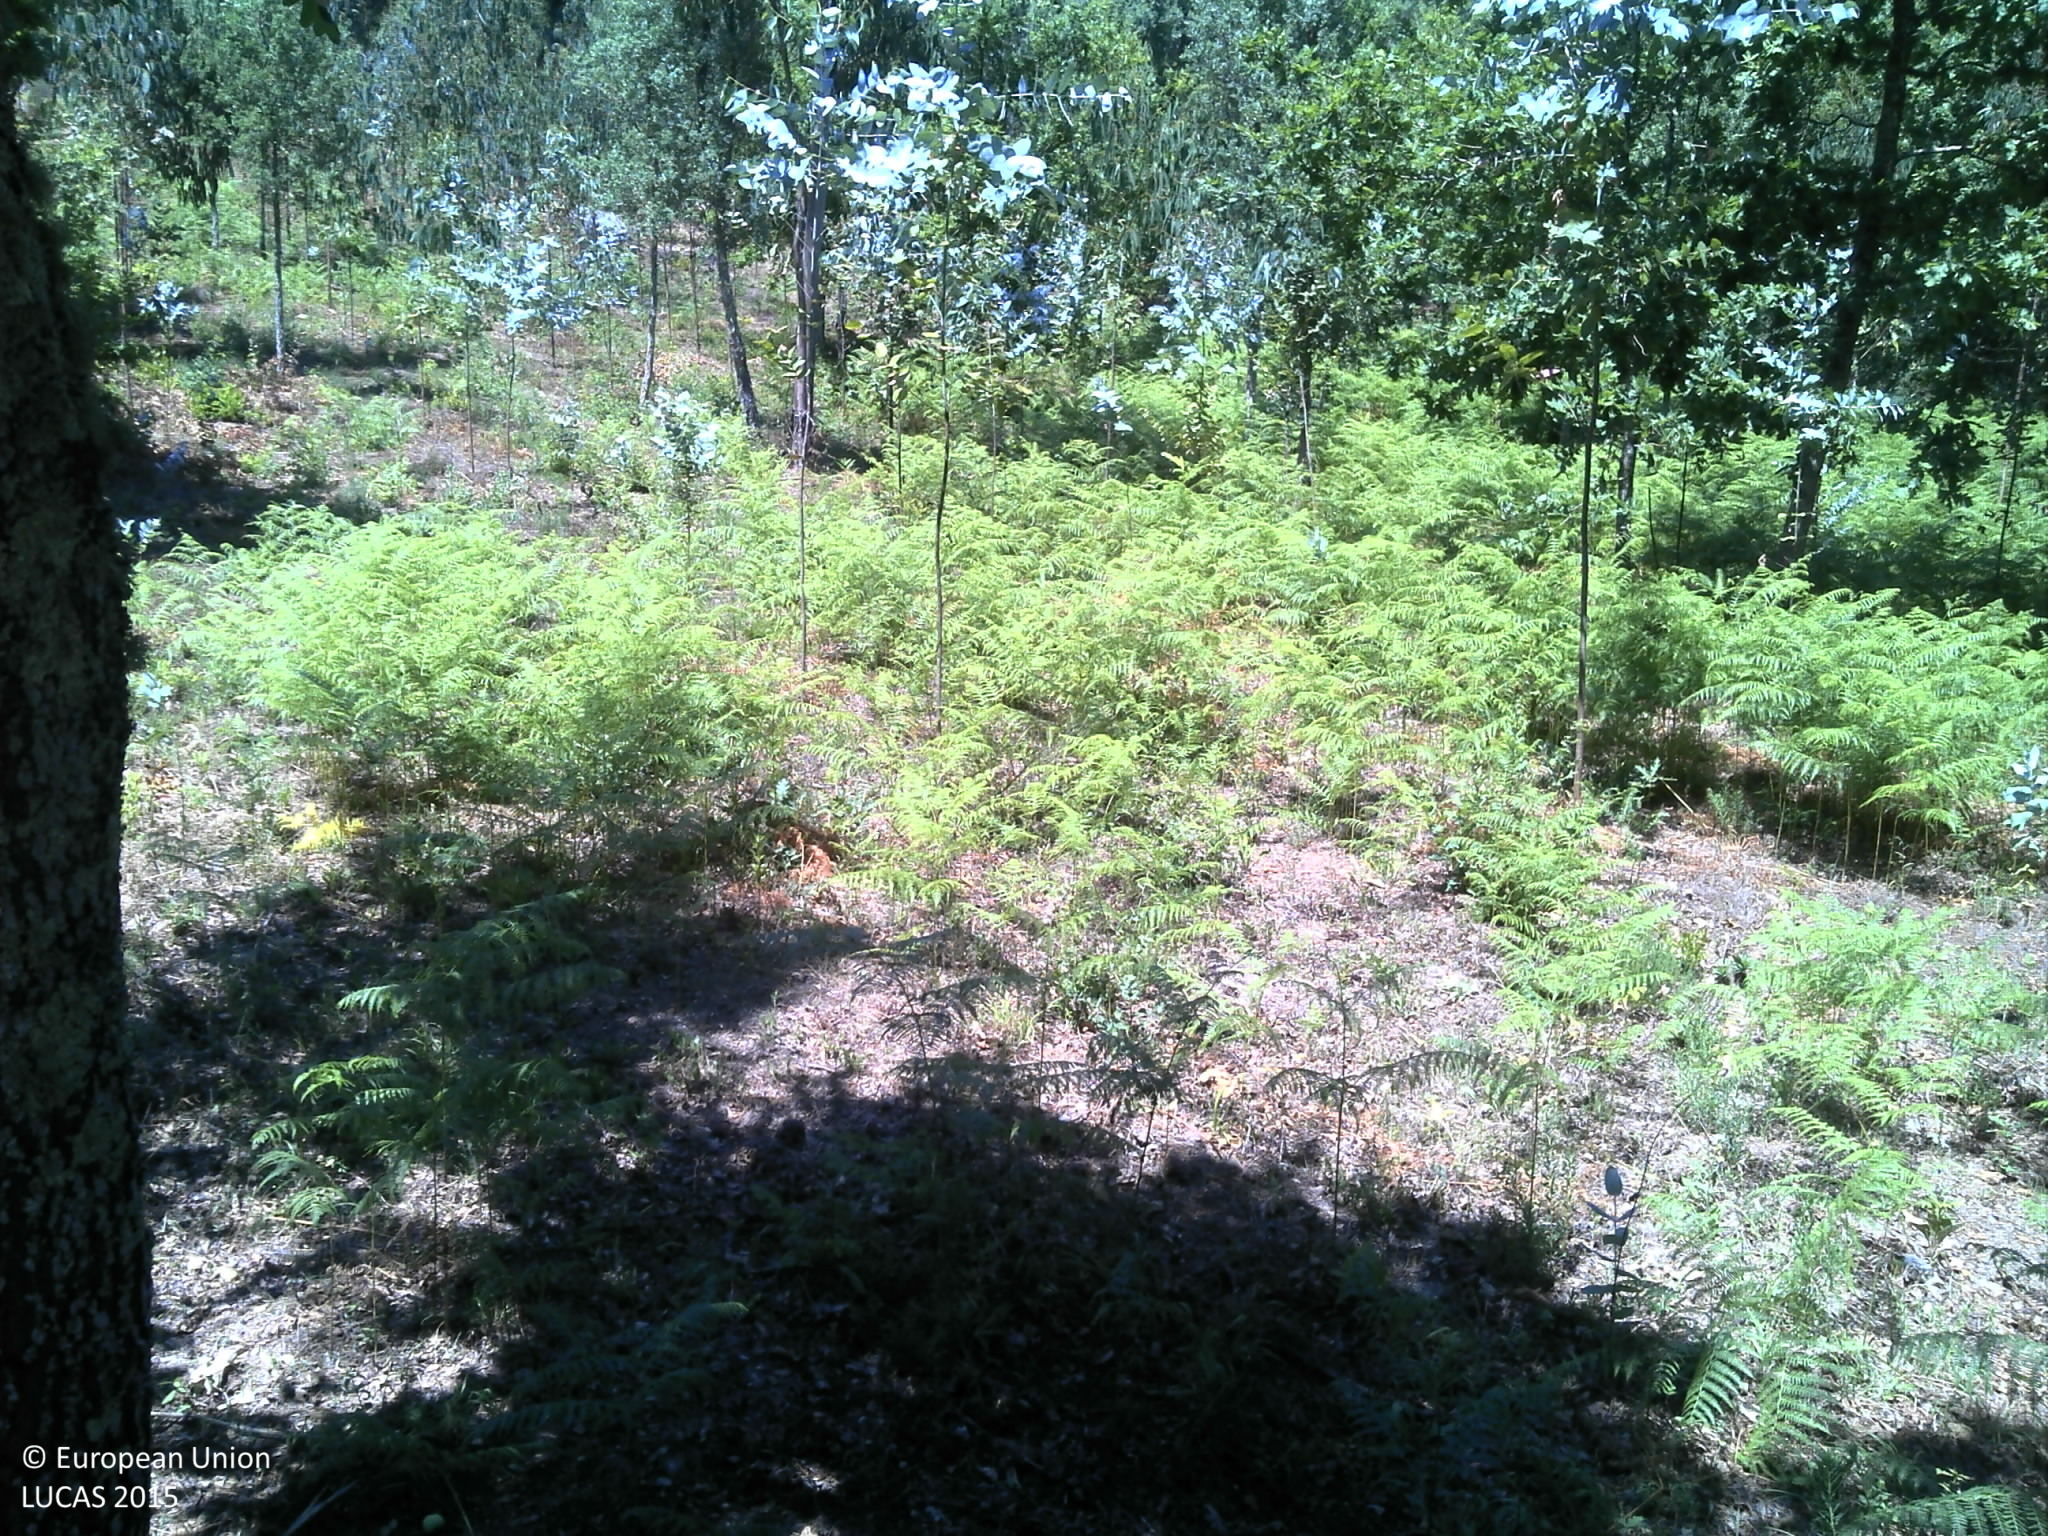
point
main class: Woodland
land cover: Broadleaved woodland
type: thermophilous deciduous forest
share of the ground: 50 - 75 %
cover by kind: broadleaved forest trees 70 %, shrubs 15 %, unconsolidated bare surface 15 %
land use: Forestry
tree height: > 5 m
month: July
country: PT
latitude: 40.3503
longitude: -7.9573
